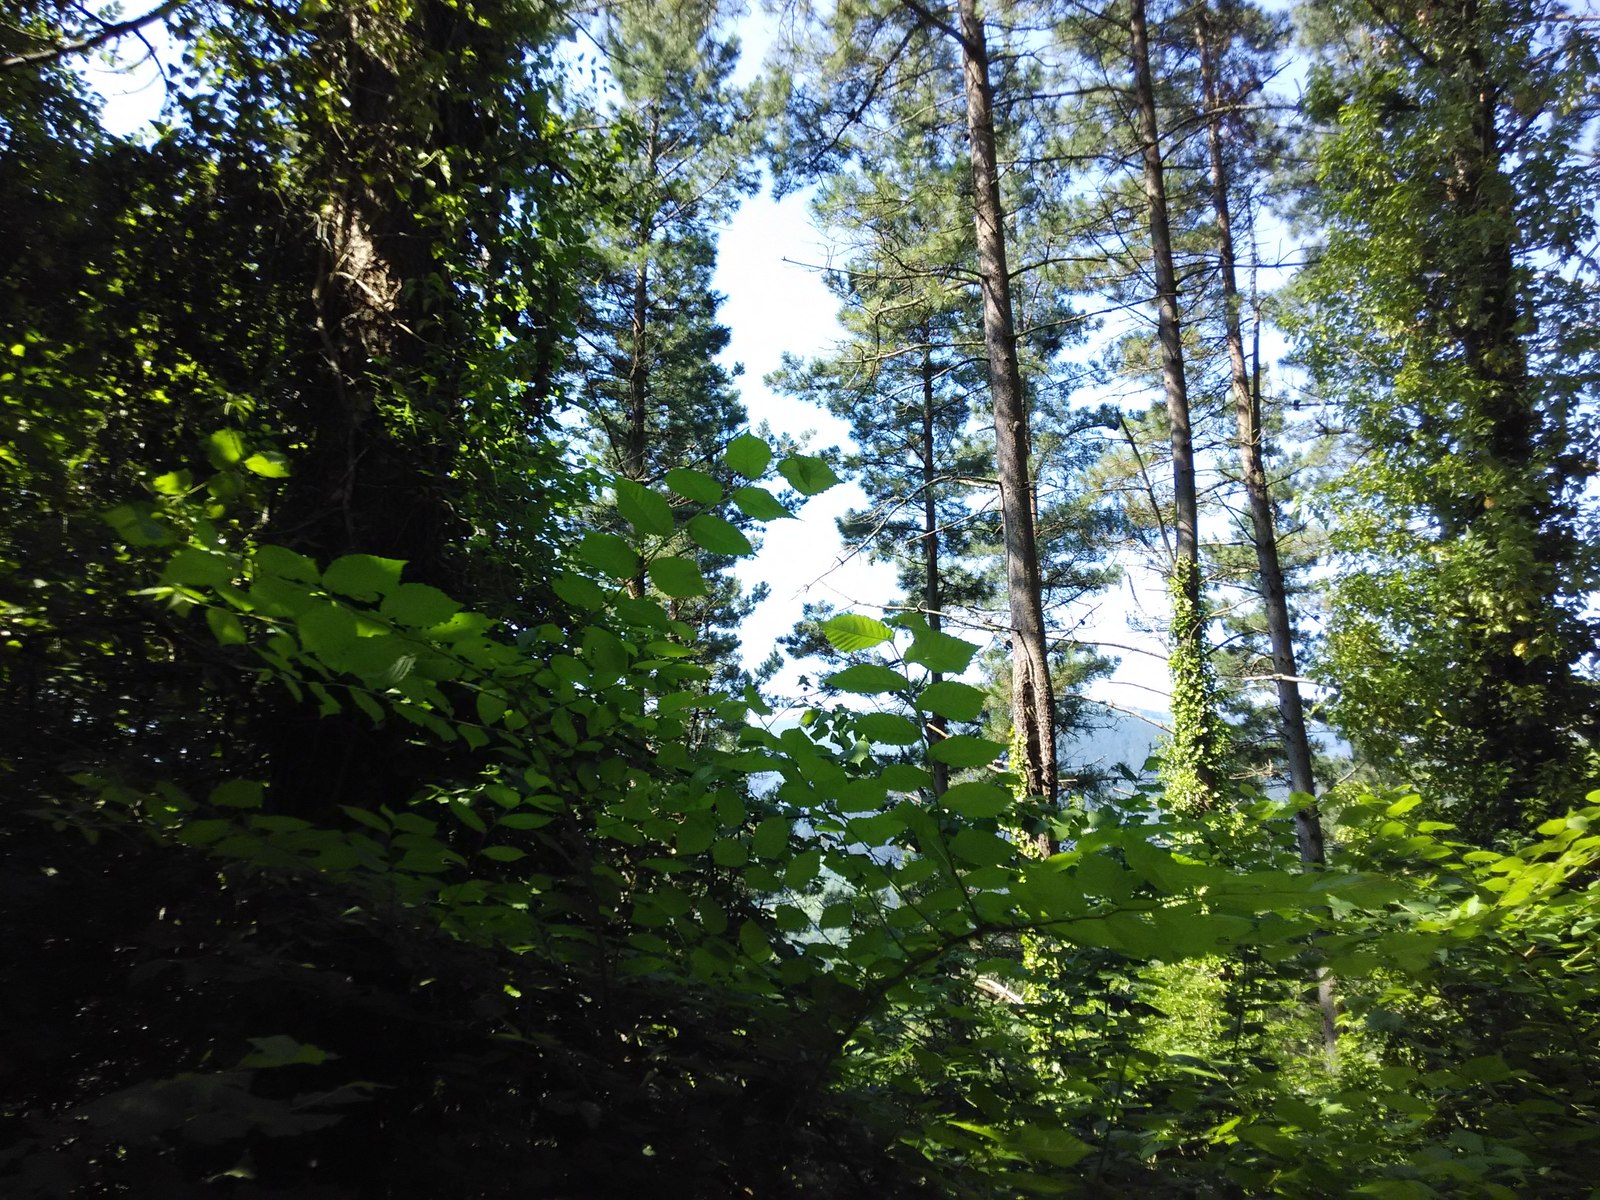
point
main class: Woodland
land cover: Pine dominated coniferous woodland
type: exotic forest
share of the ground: > 75 %
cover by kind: coniferous forest trees 75 %, broadleaved forest trees 15 %, unconsolidated bare surface 10 %
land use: Forestry
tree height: > 5 m
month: June
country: ES
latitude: 43.2562
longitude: -2.5564
